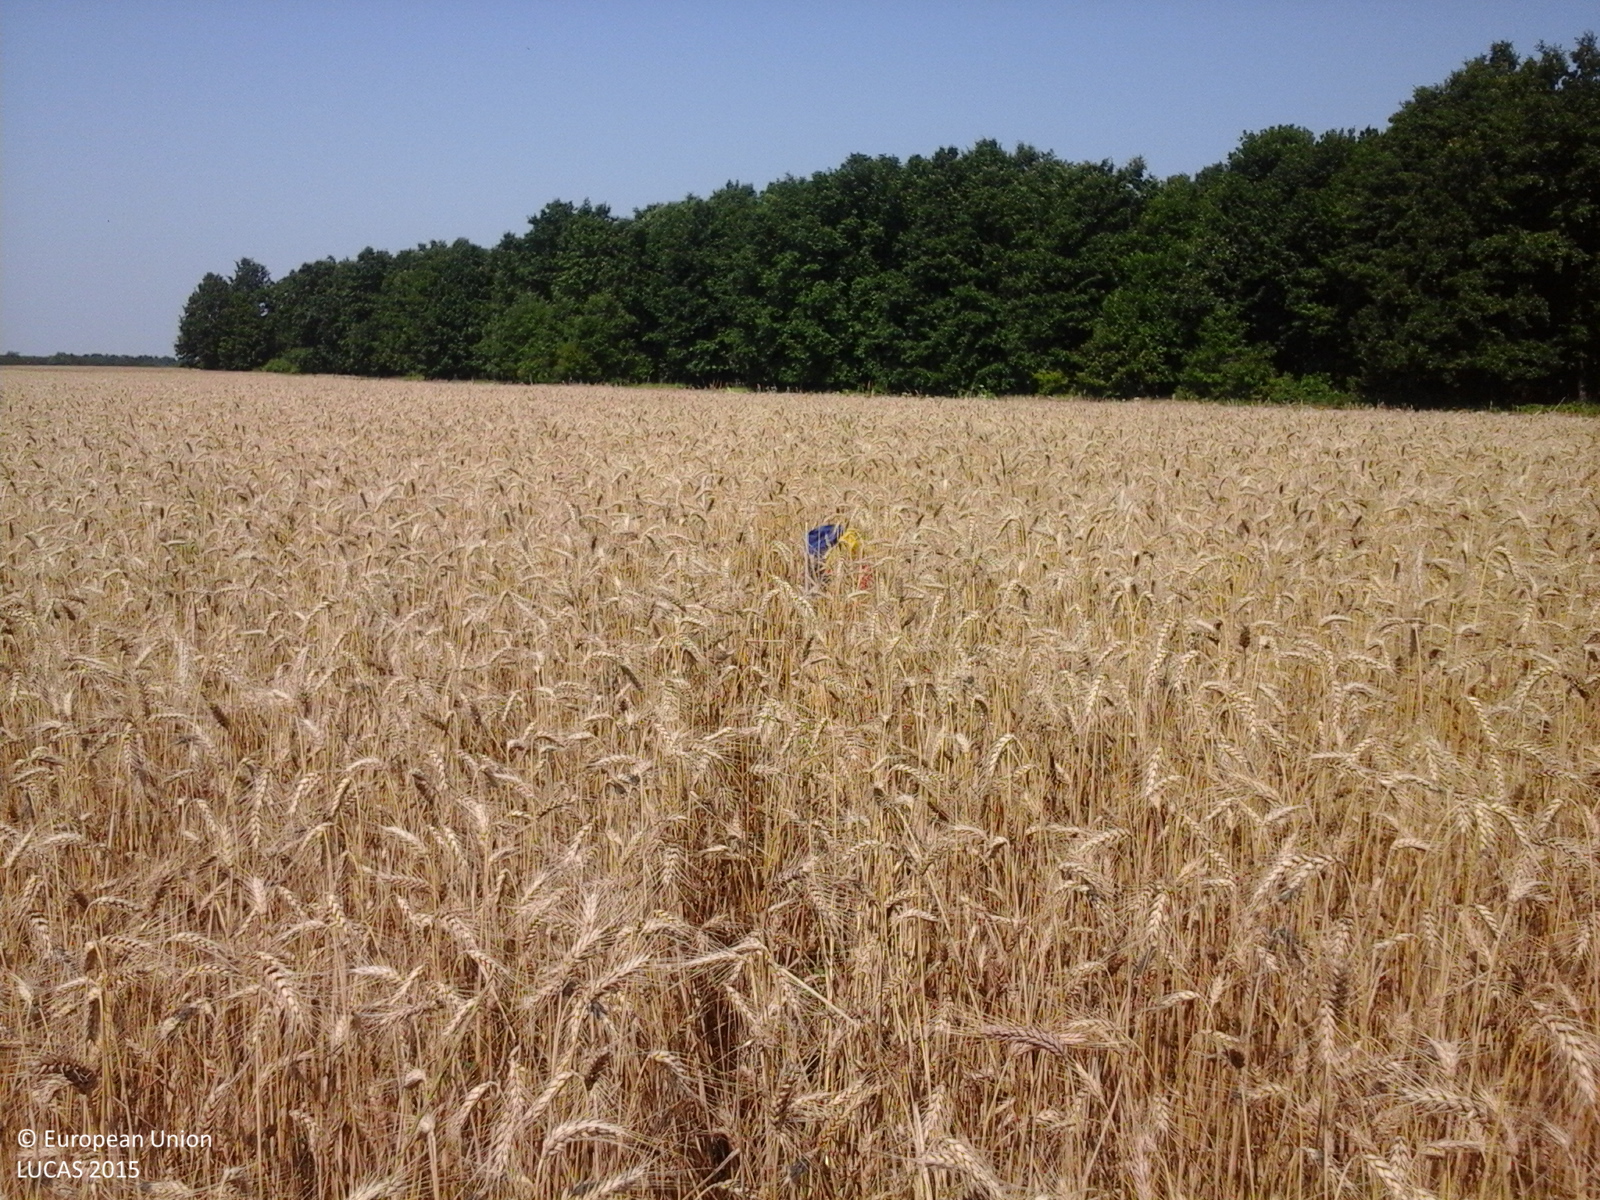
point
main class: Cropland
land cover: Common wheat
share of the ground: > 75 %
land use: Agriculture (excluding fallow land and kitchen gardens)
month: July
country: RO
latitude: 44.6845
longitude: 24.8540
